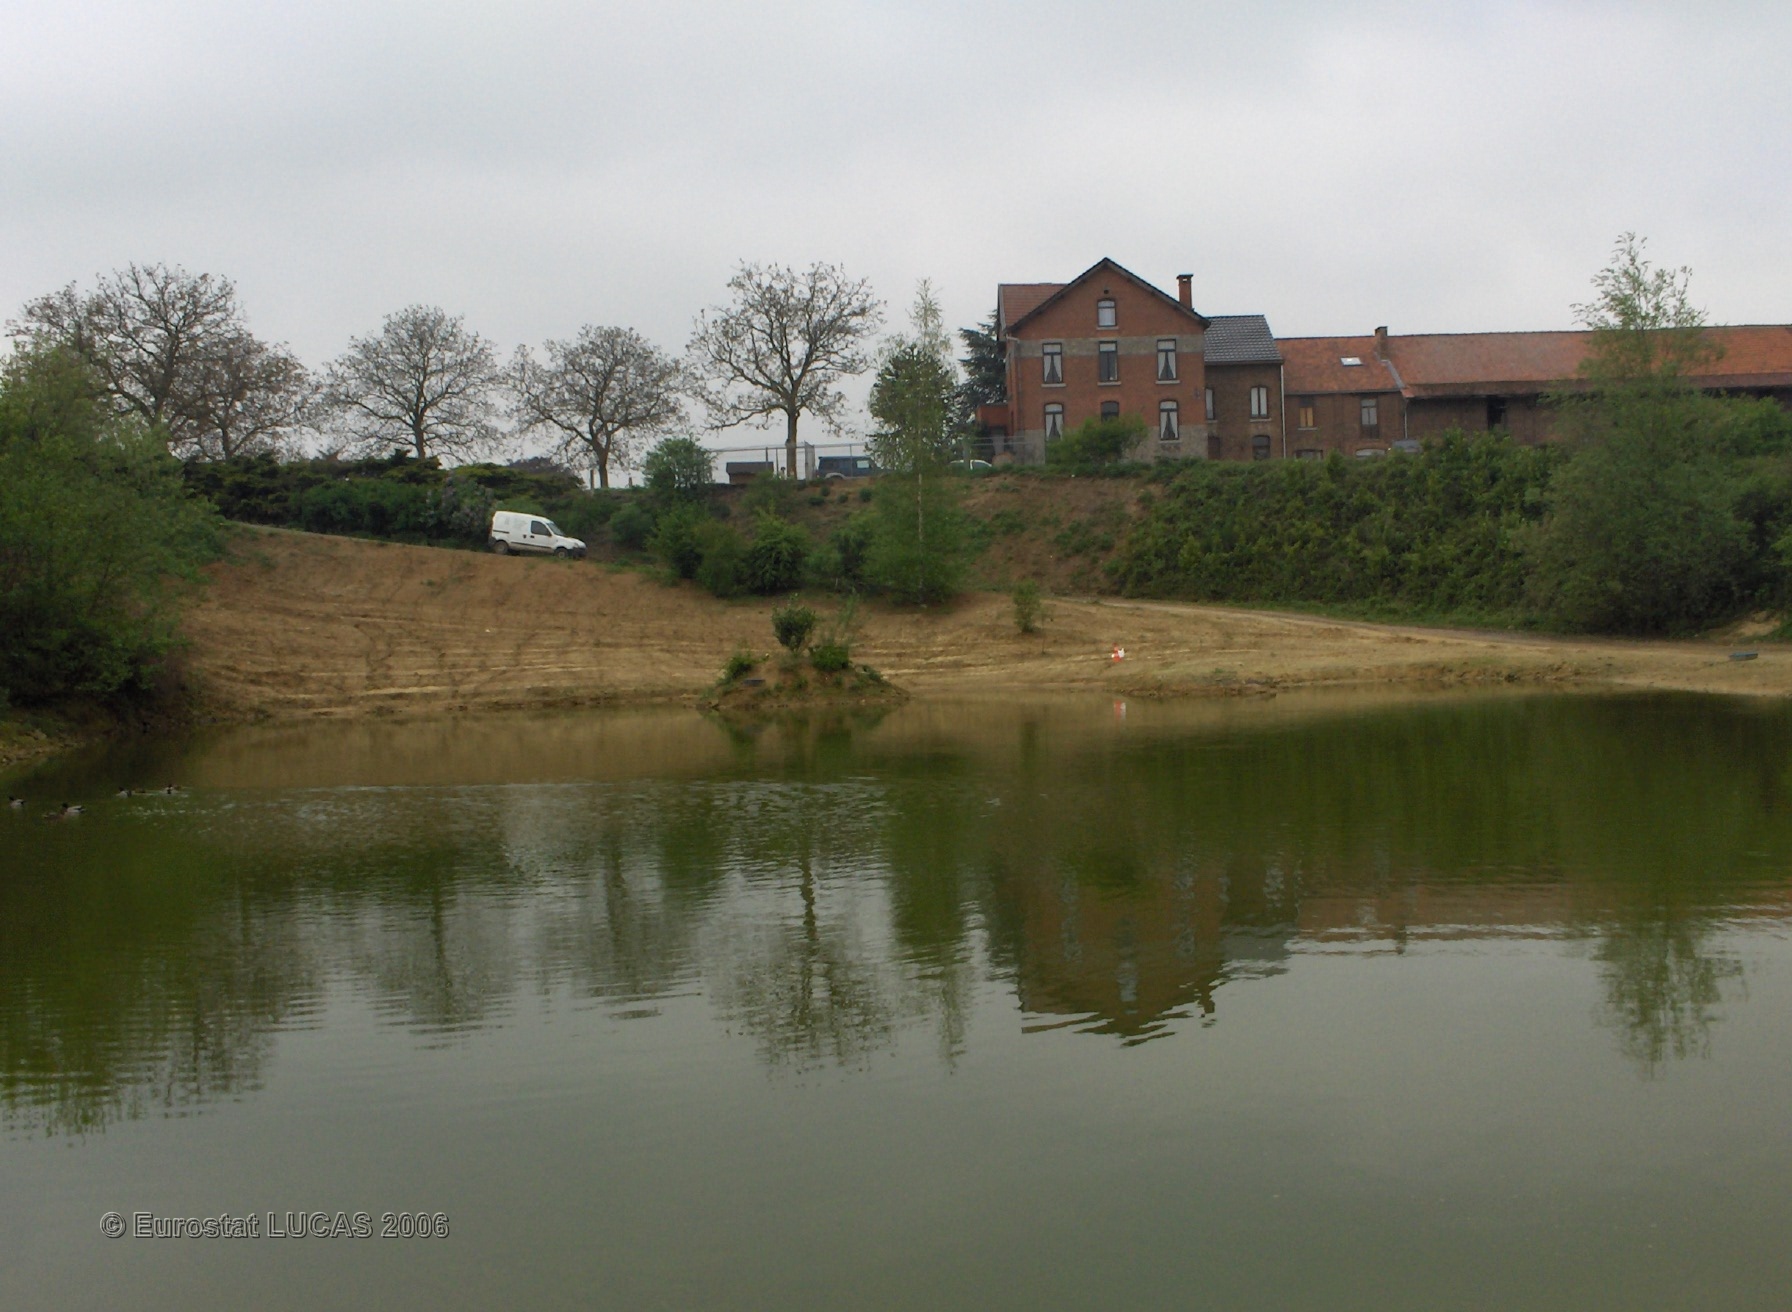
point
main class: Water areas
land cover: Inland water bodies
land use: Unused
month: May
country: BE
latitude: 50.5591
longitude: 4.5613
